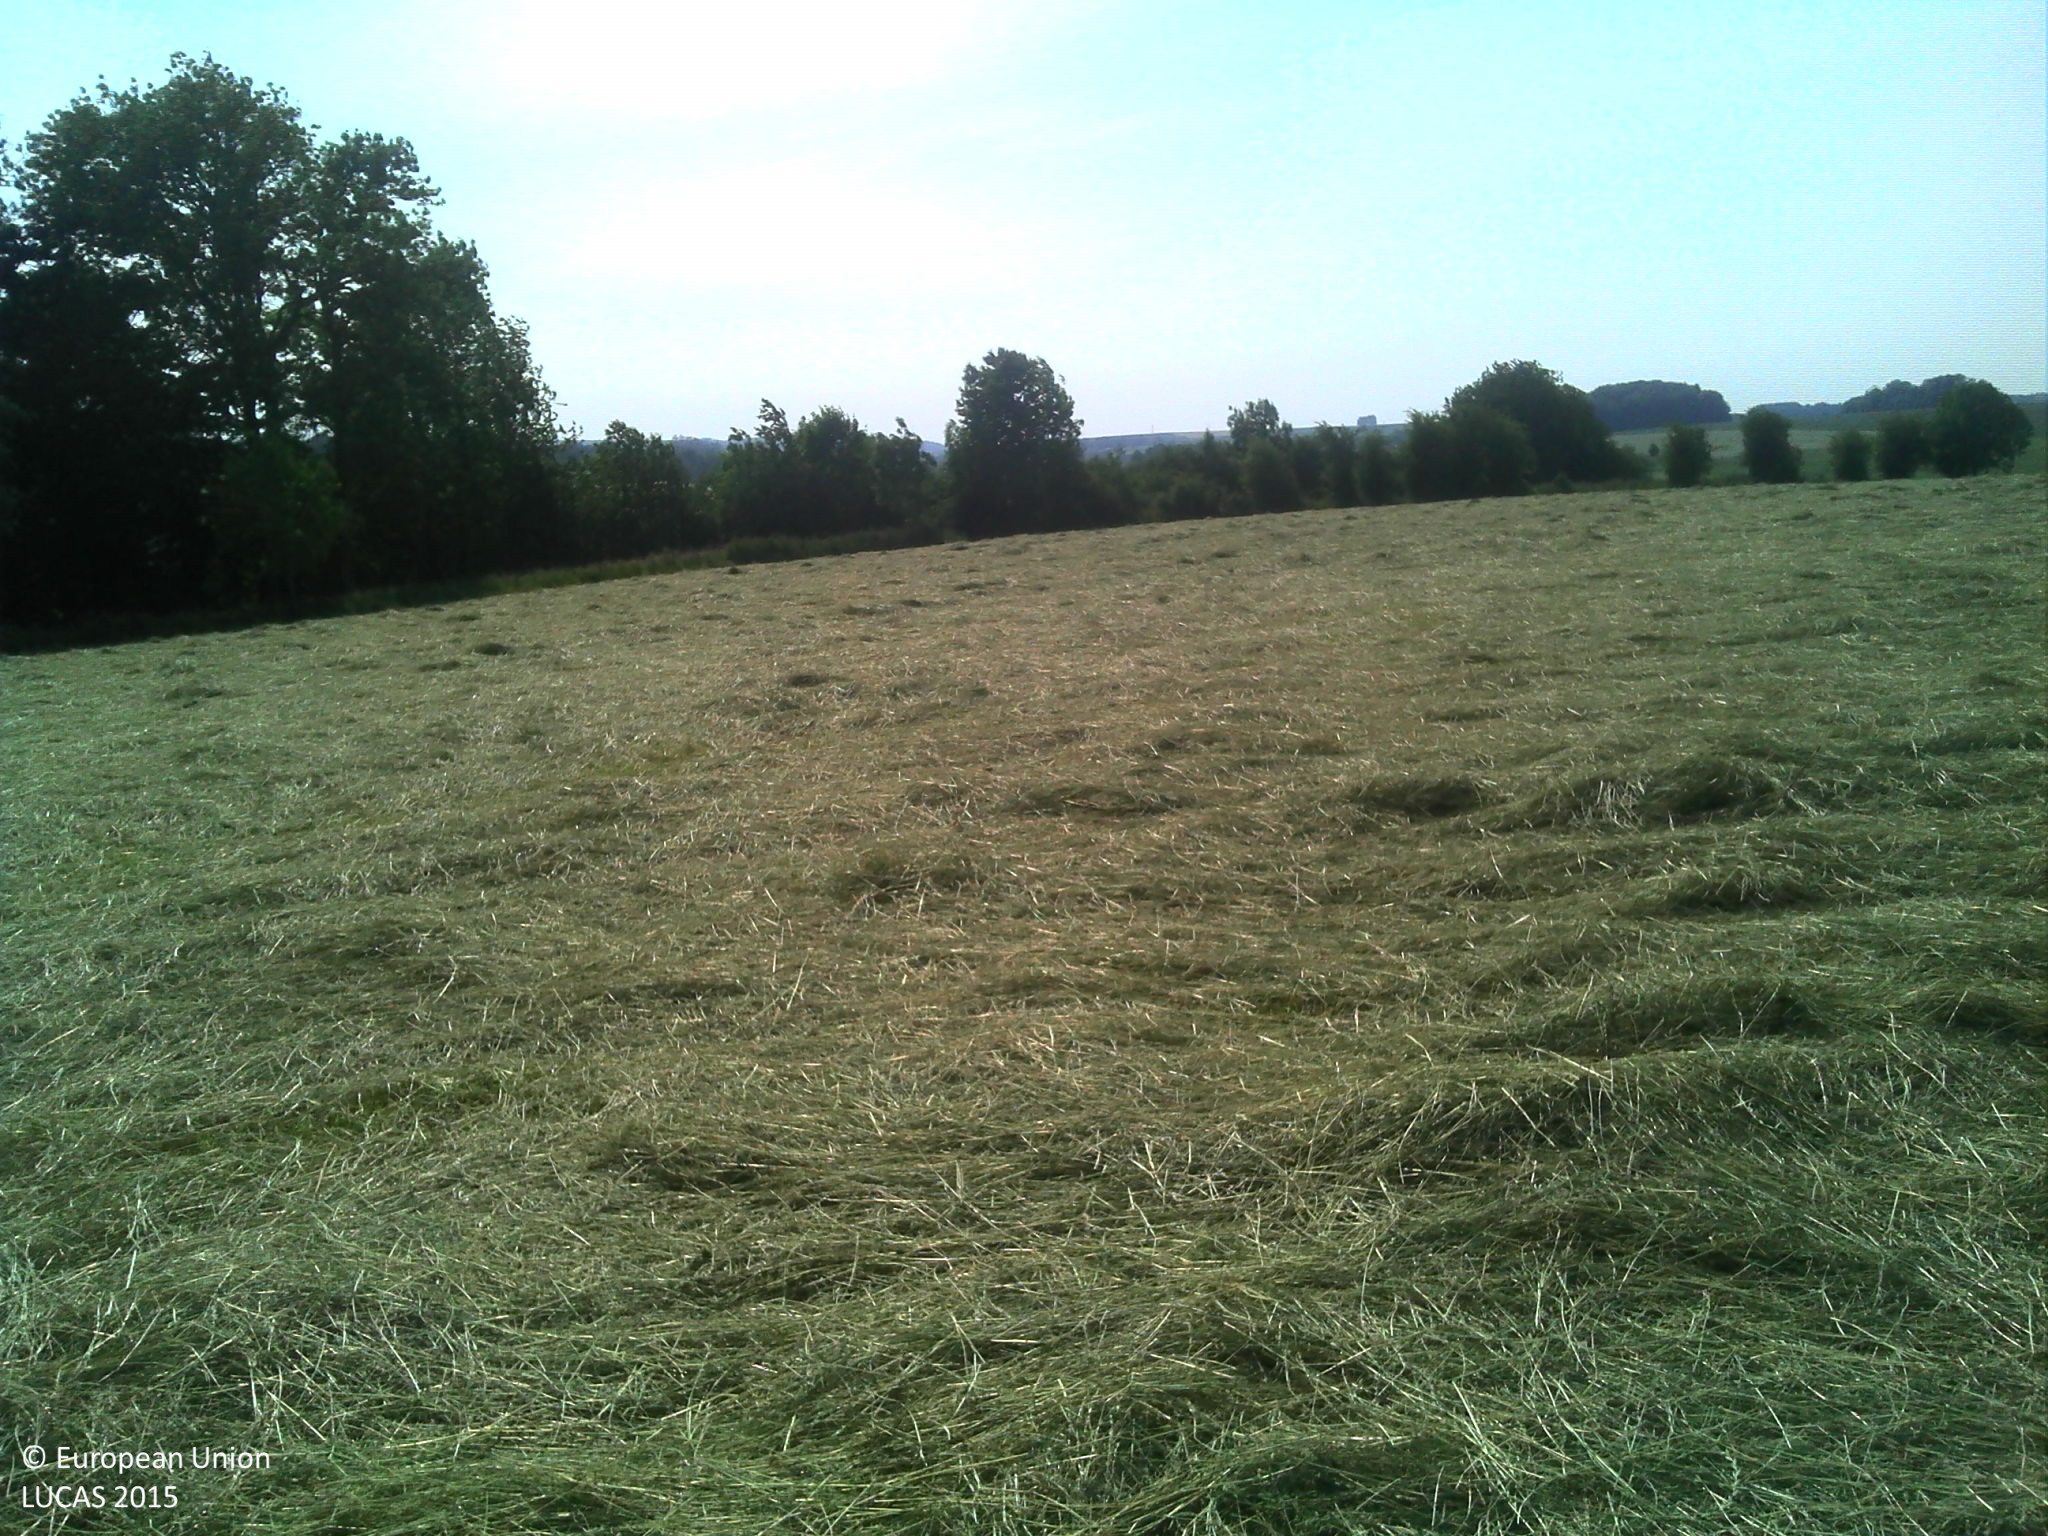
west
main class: Grassland
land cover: Grassland without tree/shrub cover
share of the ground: > 75 %
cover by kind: herbaceous plants 100 %
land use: Agriculture (excluding fallow land and kitchen gardens)
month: June
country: FR
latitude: 49.7787
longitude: 4.0928
